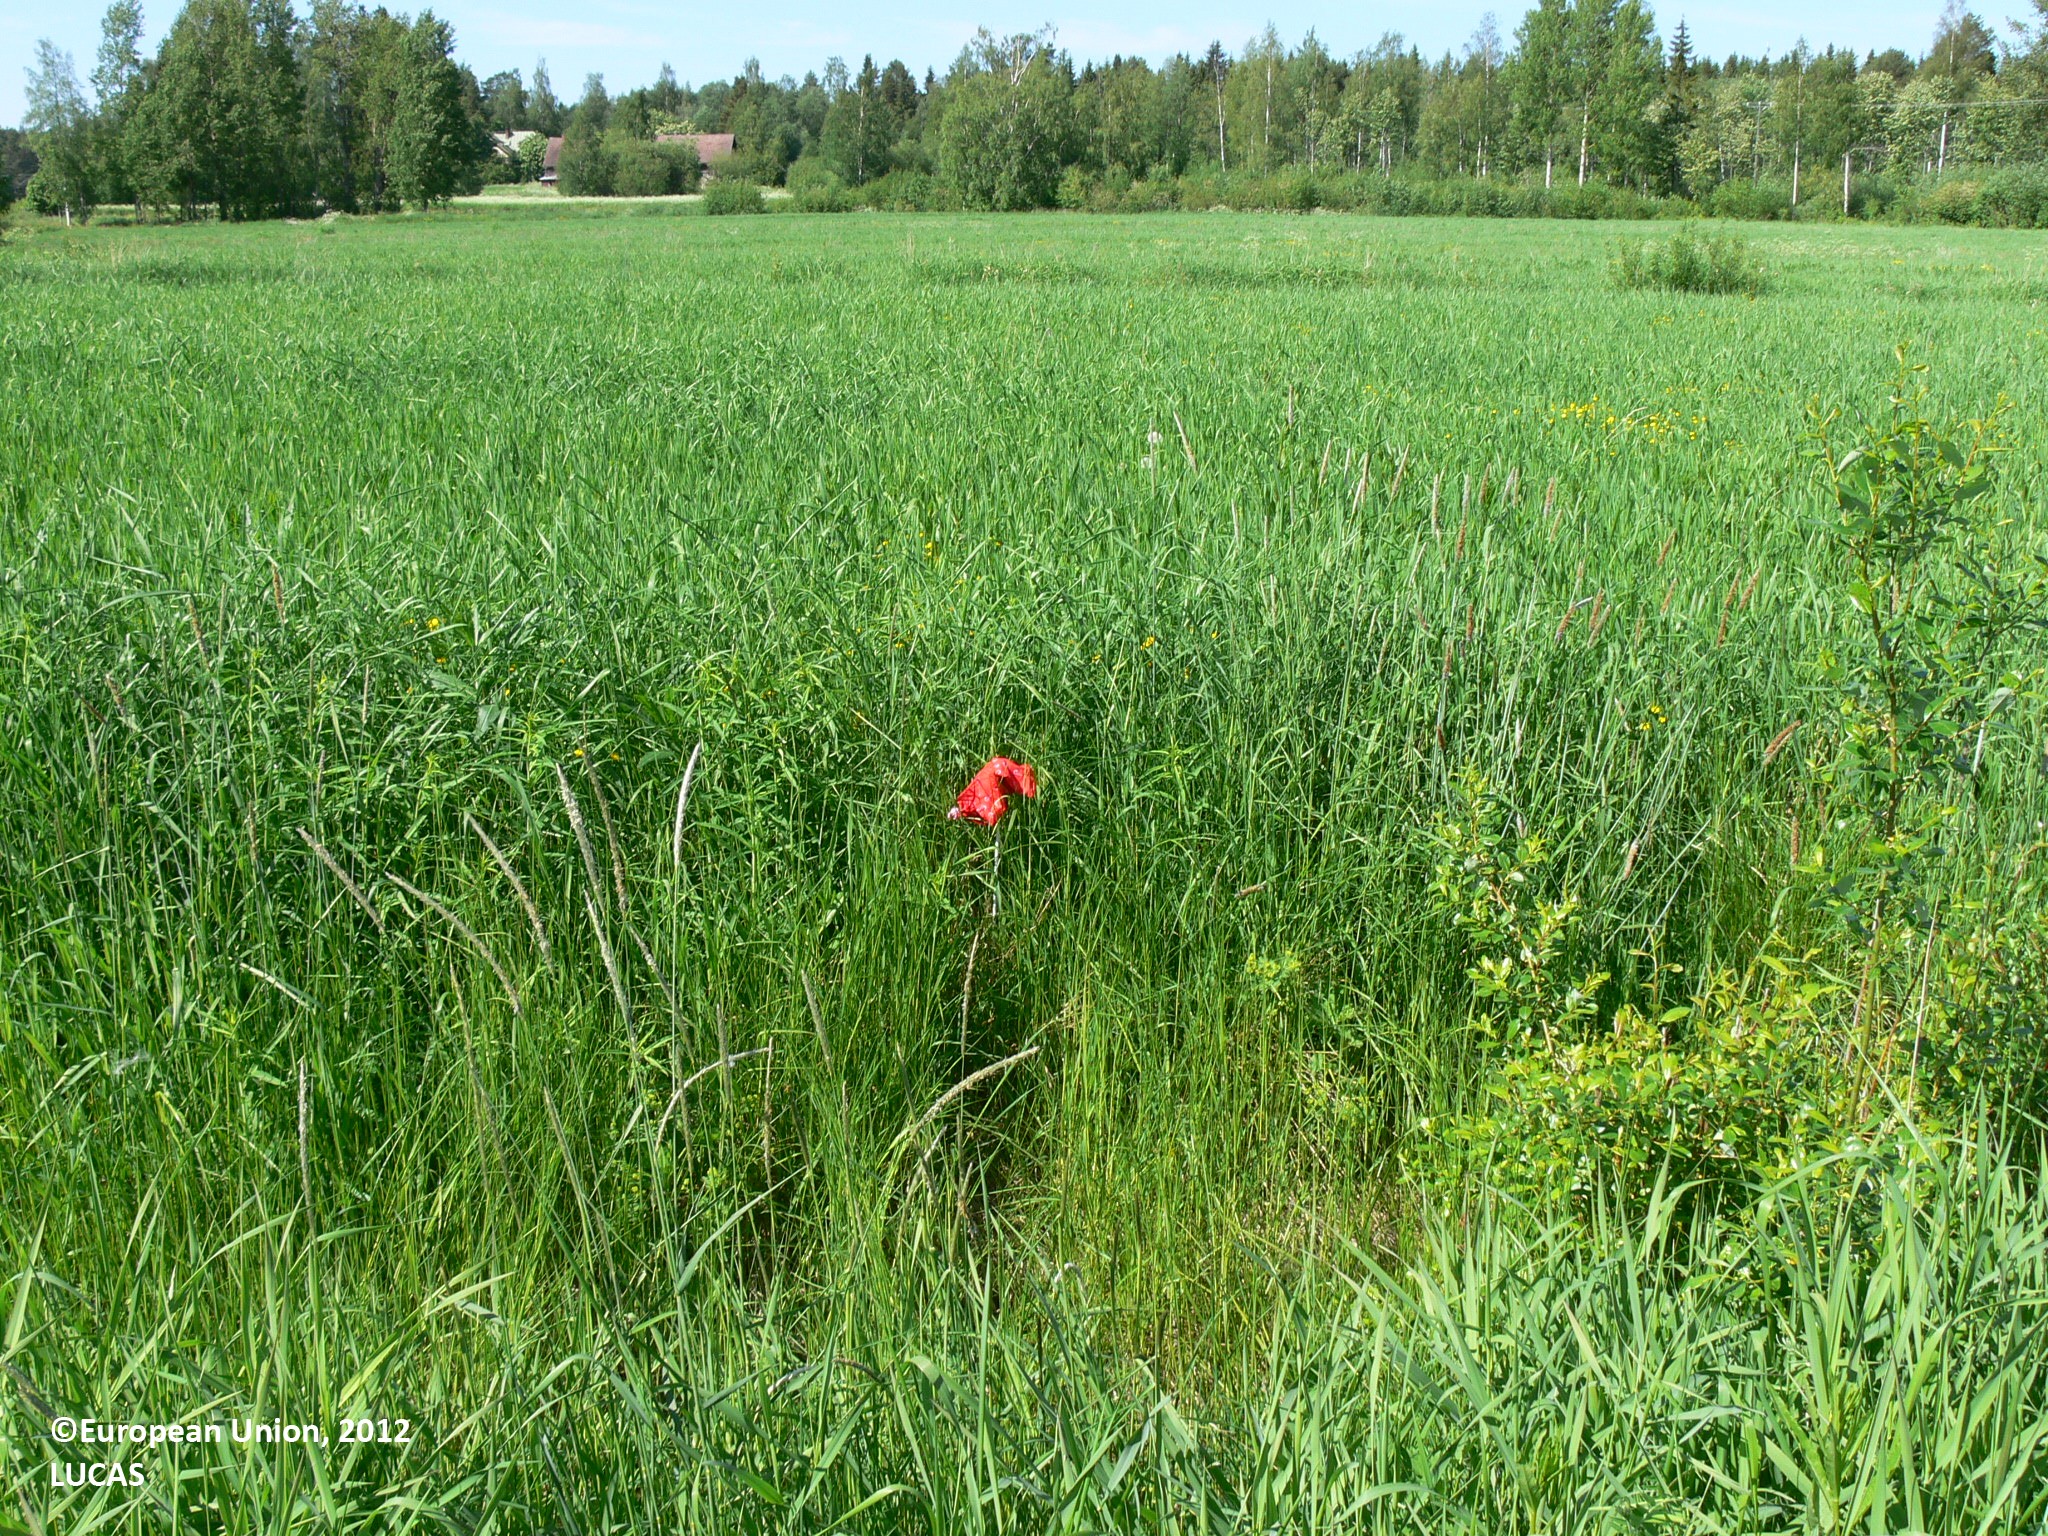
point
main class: Cropland
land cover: Temporary grasslands
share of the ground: > 75 %
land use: Agriculture (excluding fallow land and kitchen gardens)
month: June
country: FI
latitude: 62.5653
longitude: 29.8036
